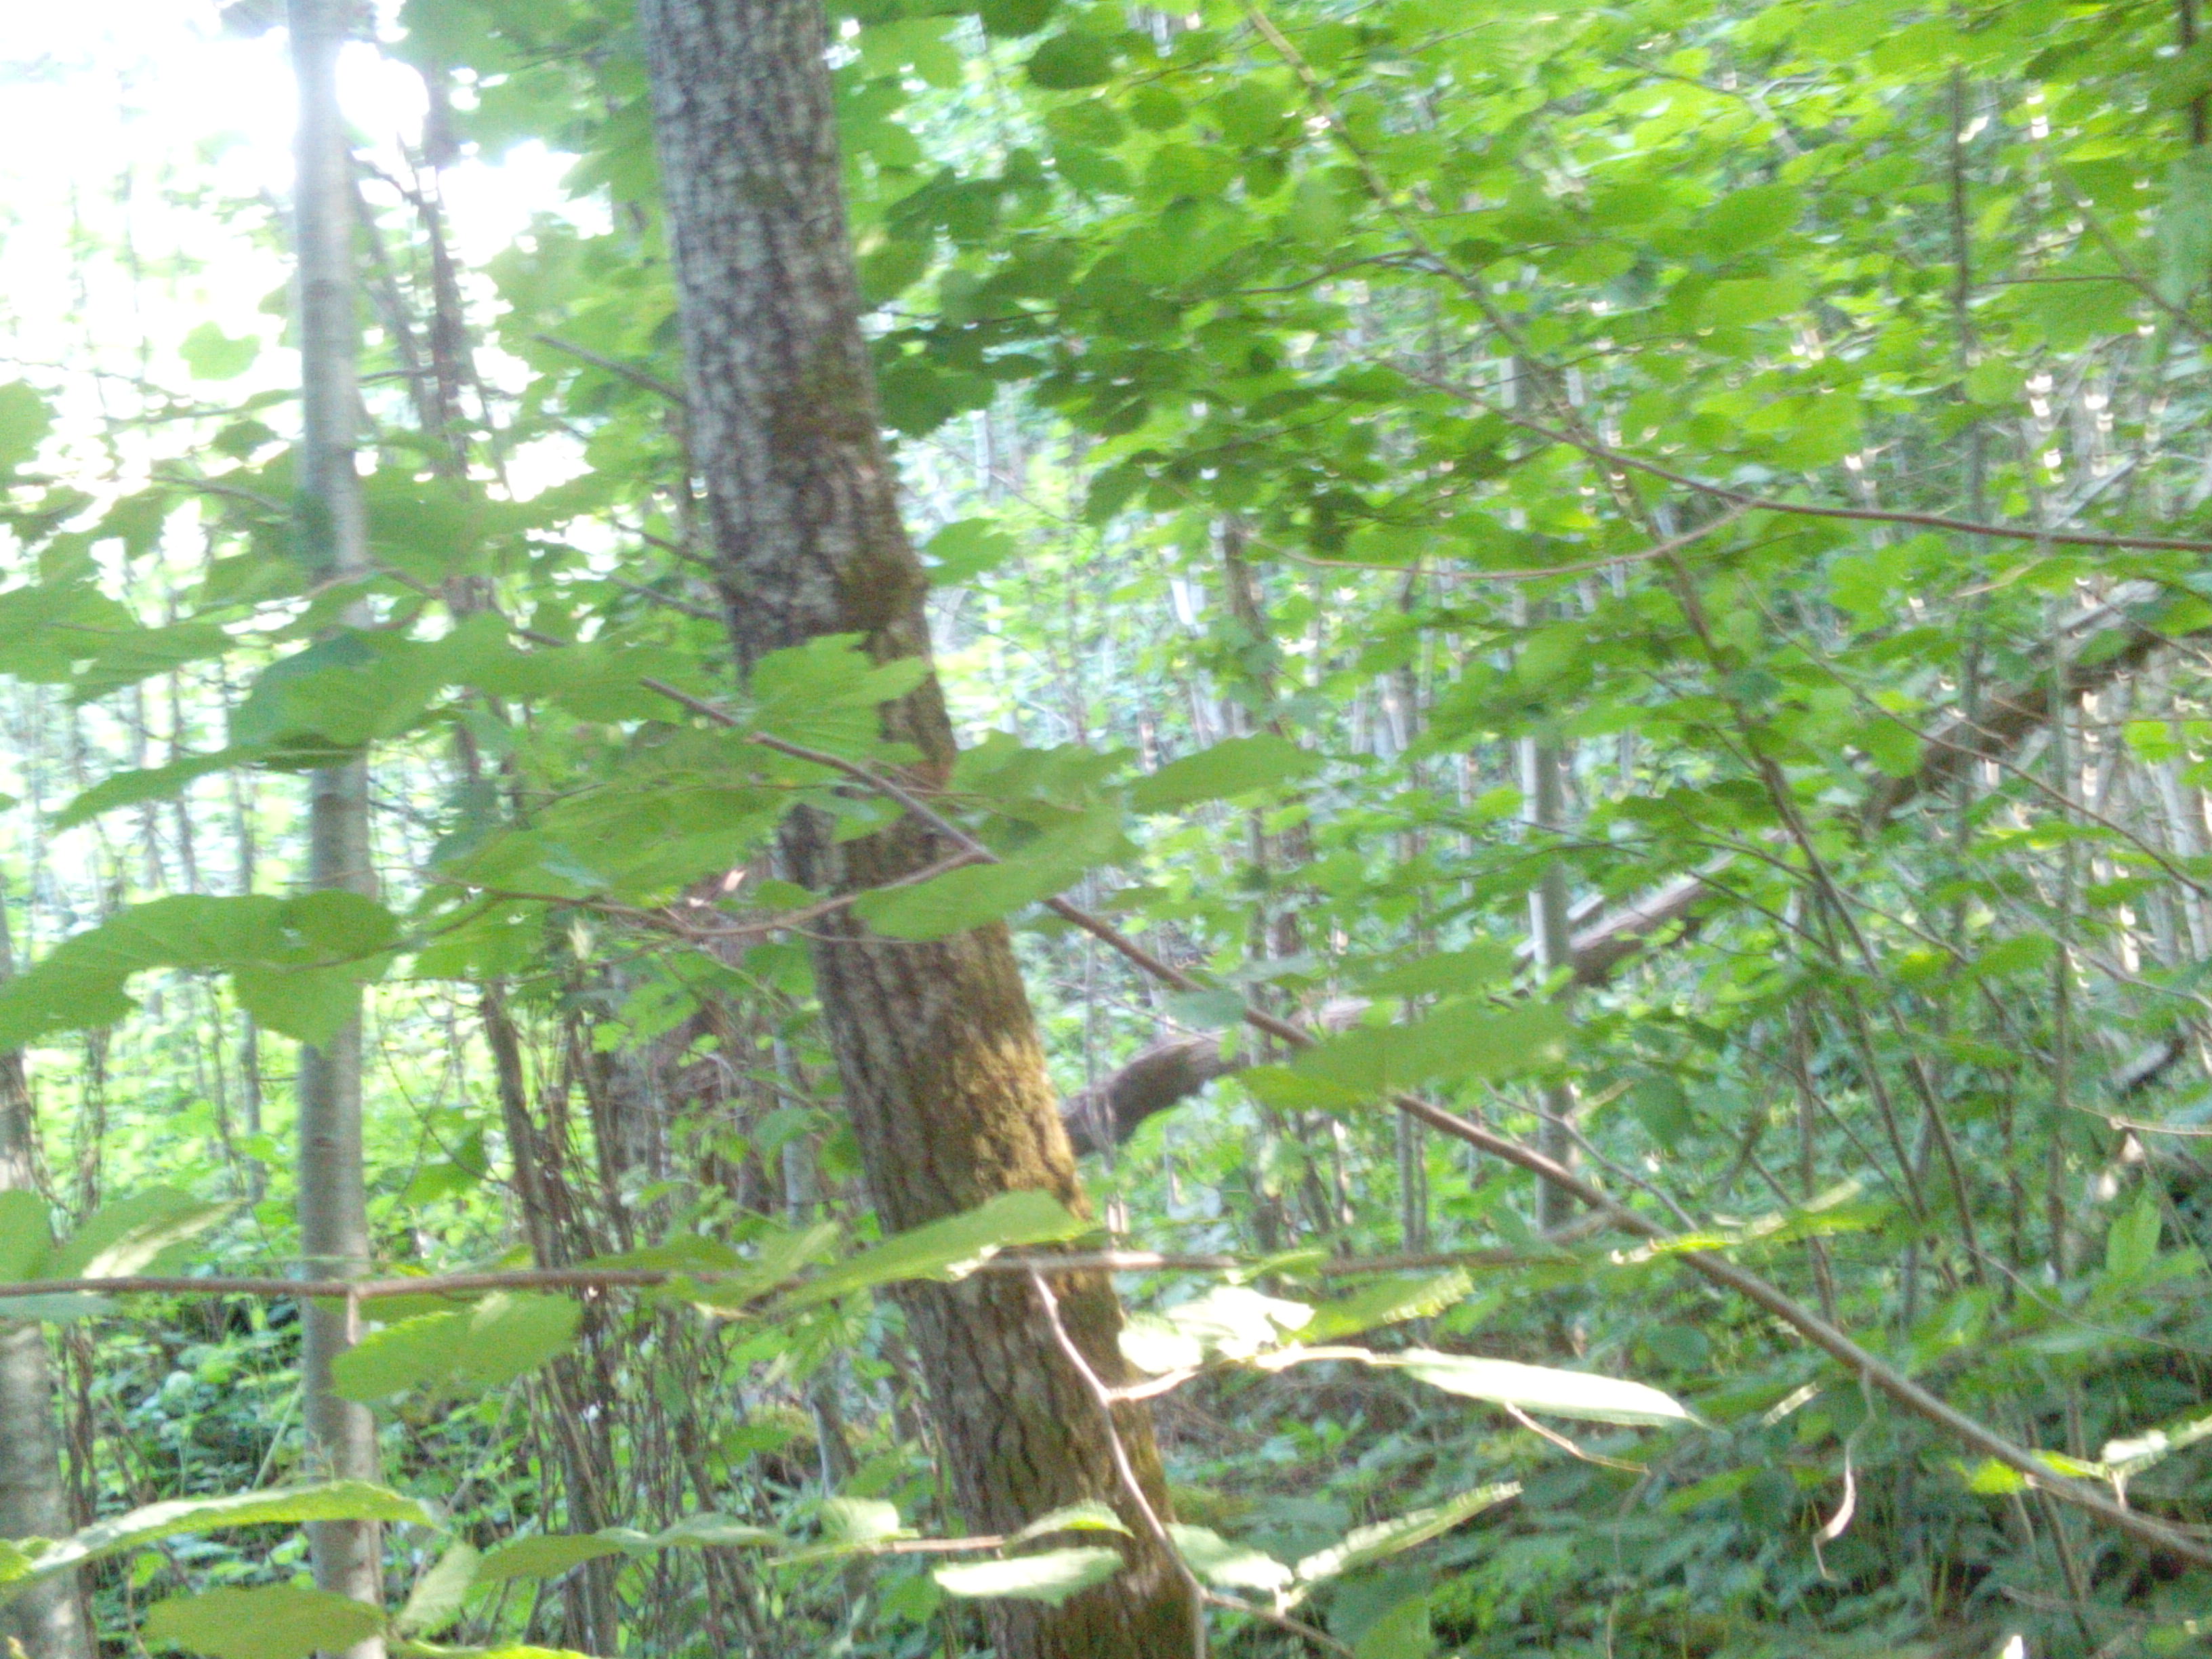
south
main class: Woodland
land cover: Broadleaved woodland
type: non-riverine alder, birch or aspen forest
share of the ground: > 75 %
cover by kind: broadleaved forest trees 85 %, herbaceous plants 10 %, shrubs 5 %
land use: Forestry
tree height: > 5 m
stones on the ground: < 10 %
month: July
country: LV
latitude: 56.5118
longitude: 21.8283
